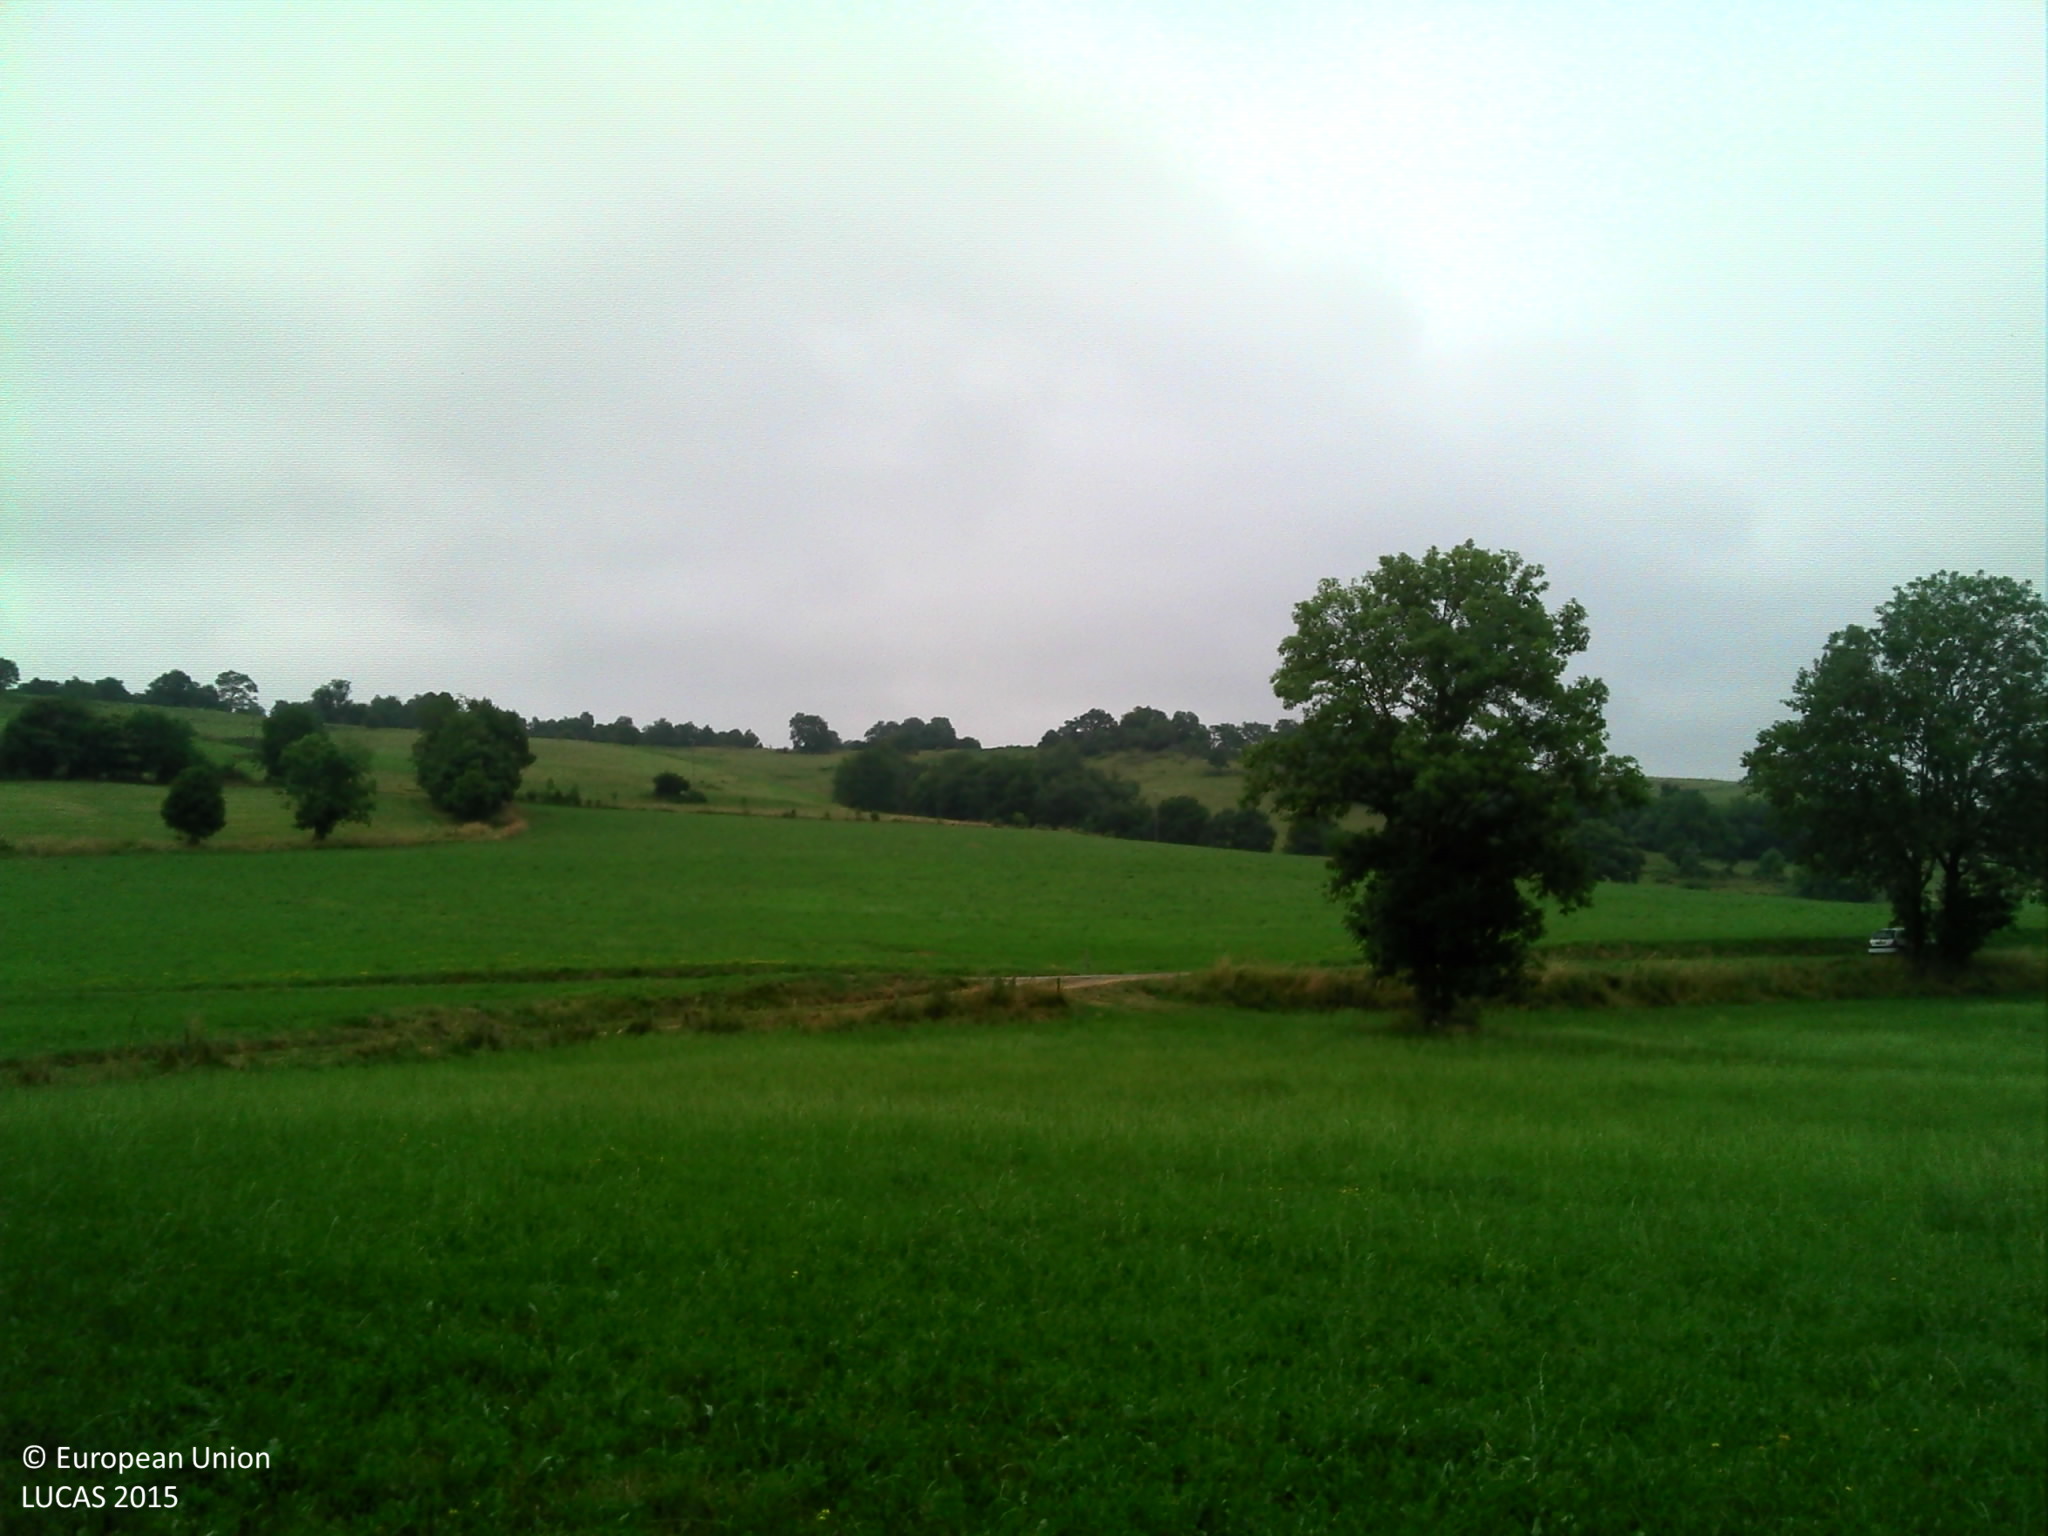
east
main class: Cropland
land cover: Temporary grasslands
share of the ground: > 75 %
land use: Agriculture (excluding fallow land and kitchen gardens)
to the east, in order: Temporary grasslands; Abandoned hedges; Temporary grasslands; Fences; Tracks; Paved roads, cycling and walking lanes; Temporary grasslands
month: July
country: FR
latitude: 43.0340
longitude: 1.4266
